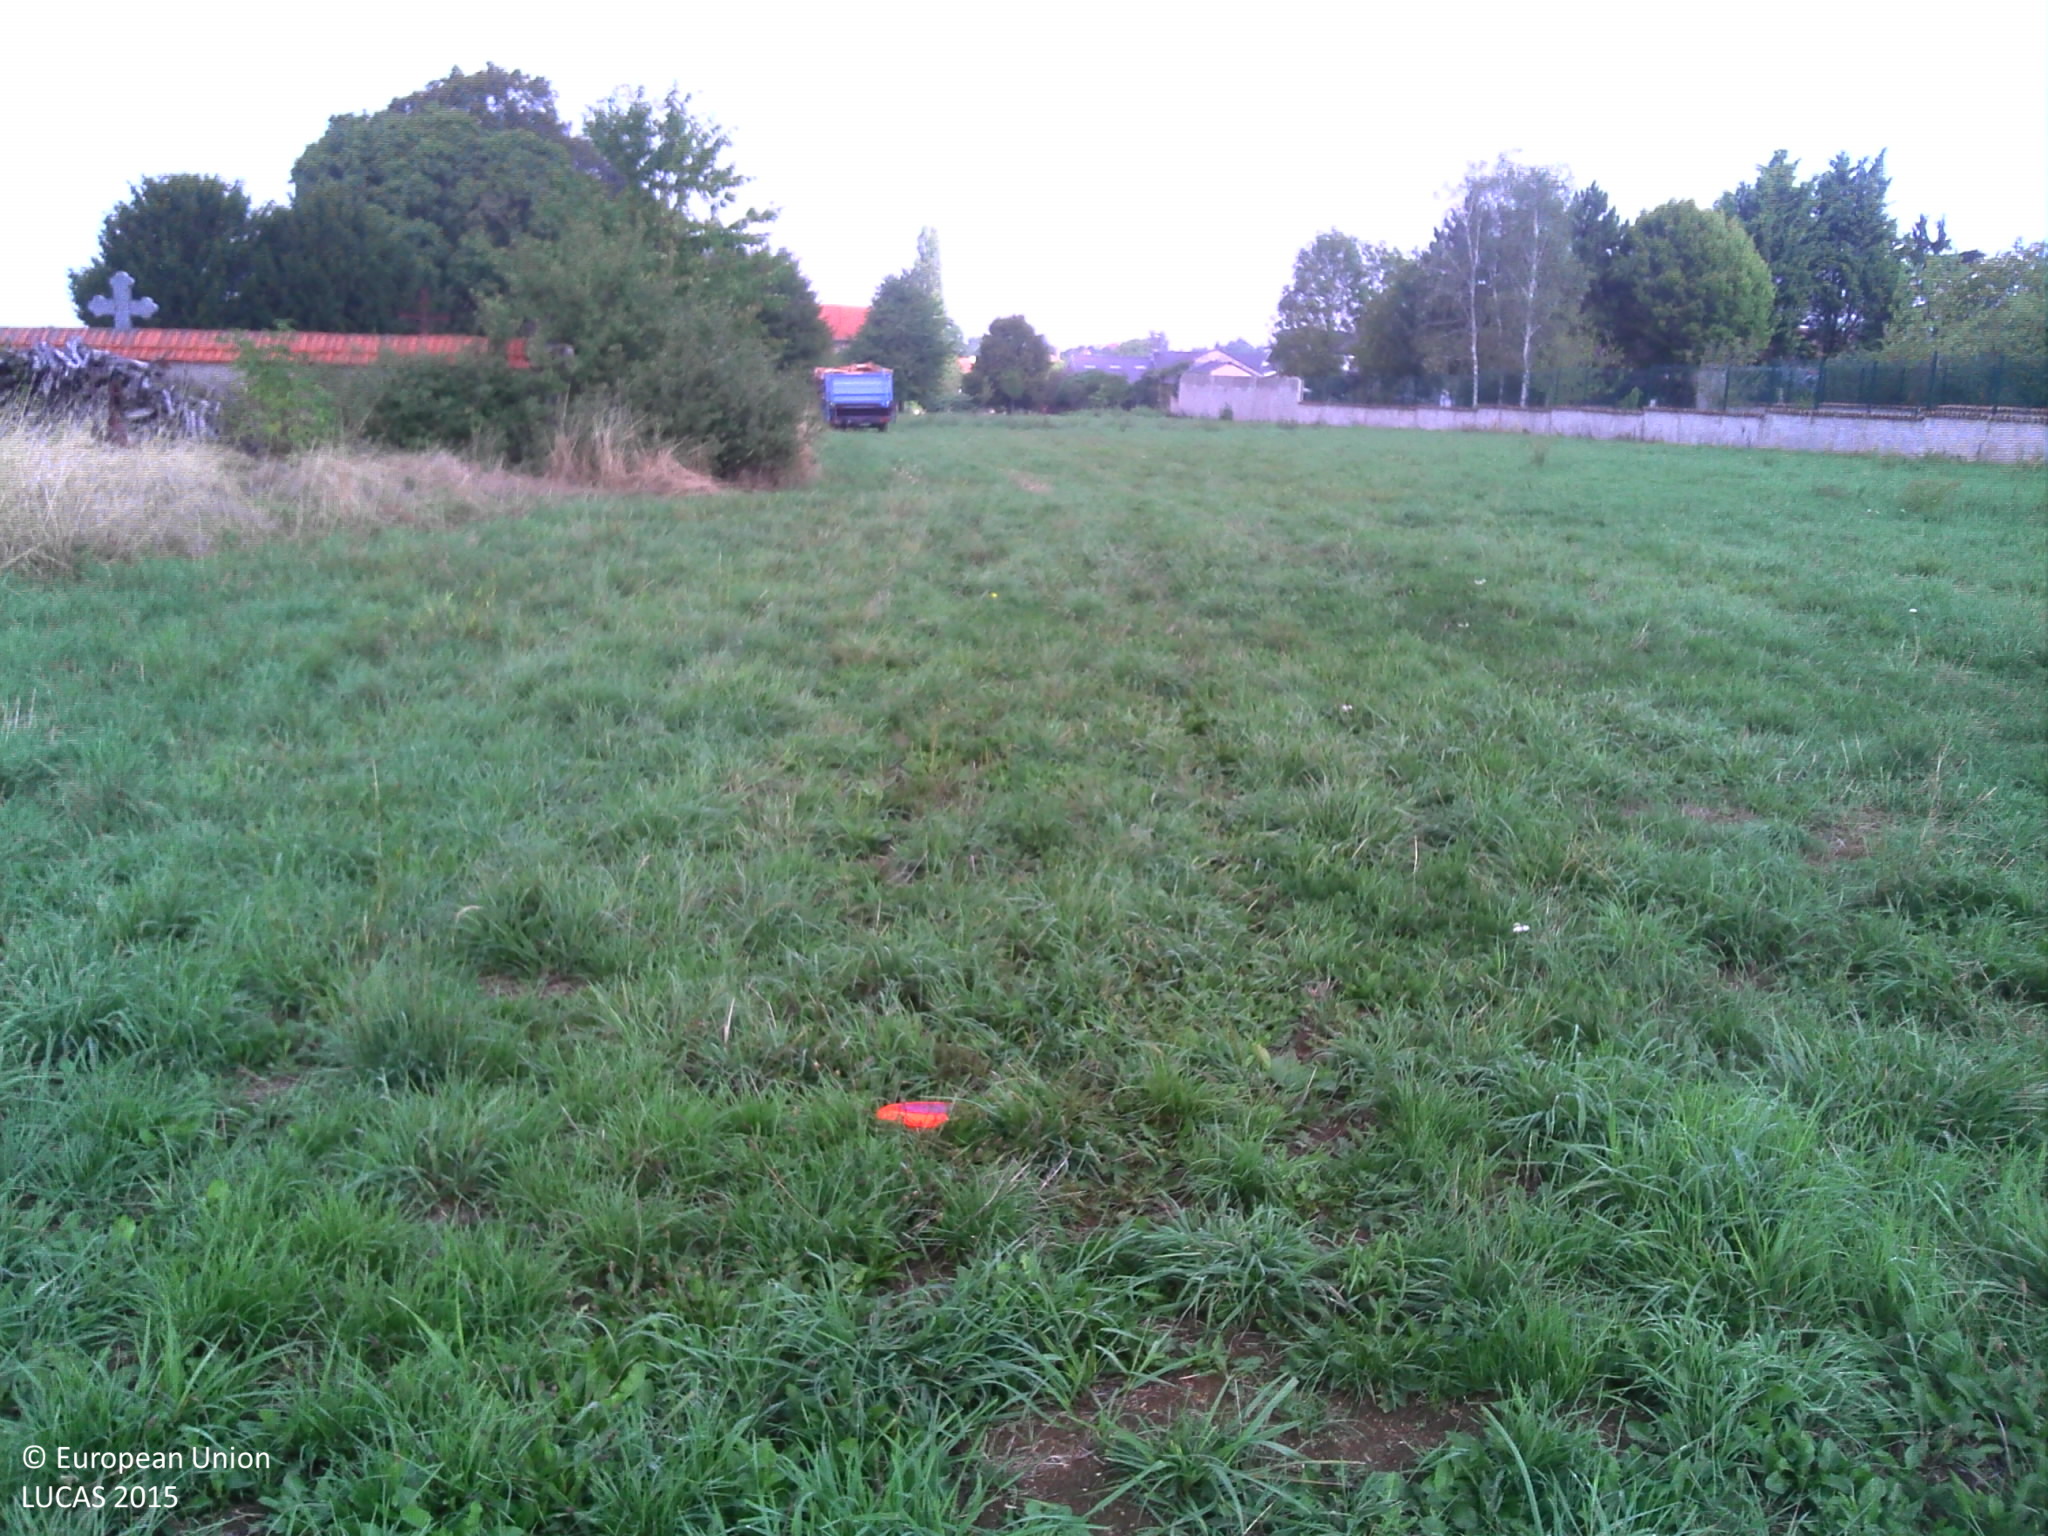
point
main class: Grassland
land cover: Grassland without tree/shrub cover
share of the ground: > 75 %
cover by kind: herbaceous plants 95 %, consolidated bare surface 5 %
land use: Agriculture (excluding fallow land and kitchen gardens)
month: September
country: FR
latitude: 49.1581
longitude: 5.9543
